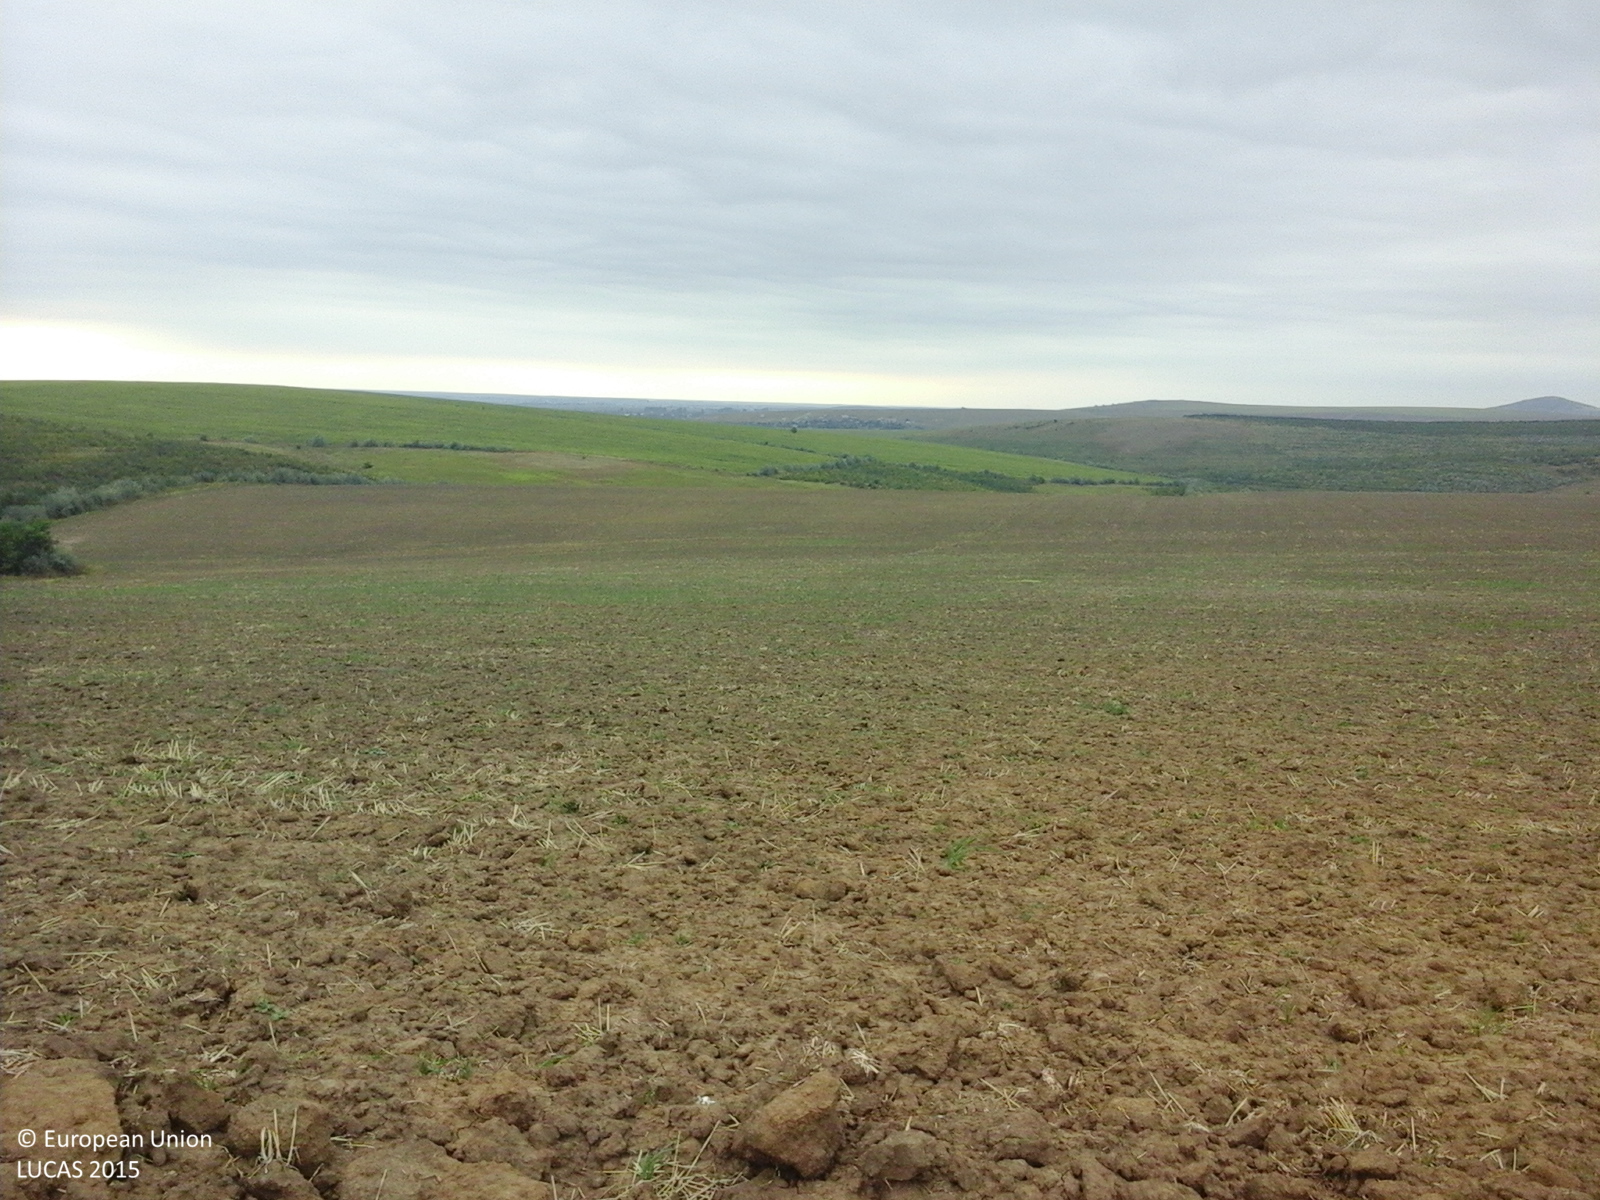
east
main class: Cropland
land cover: Common wheat
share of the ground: < 10 %
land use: Agriculture (excluding fallow land and kitchen gardens)
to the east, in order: Common wheat
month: August
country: RO
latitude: 45.1362
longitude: 28.8473
